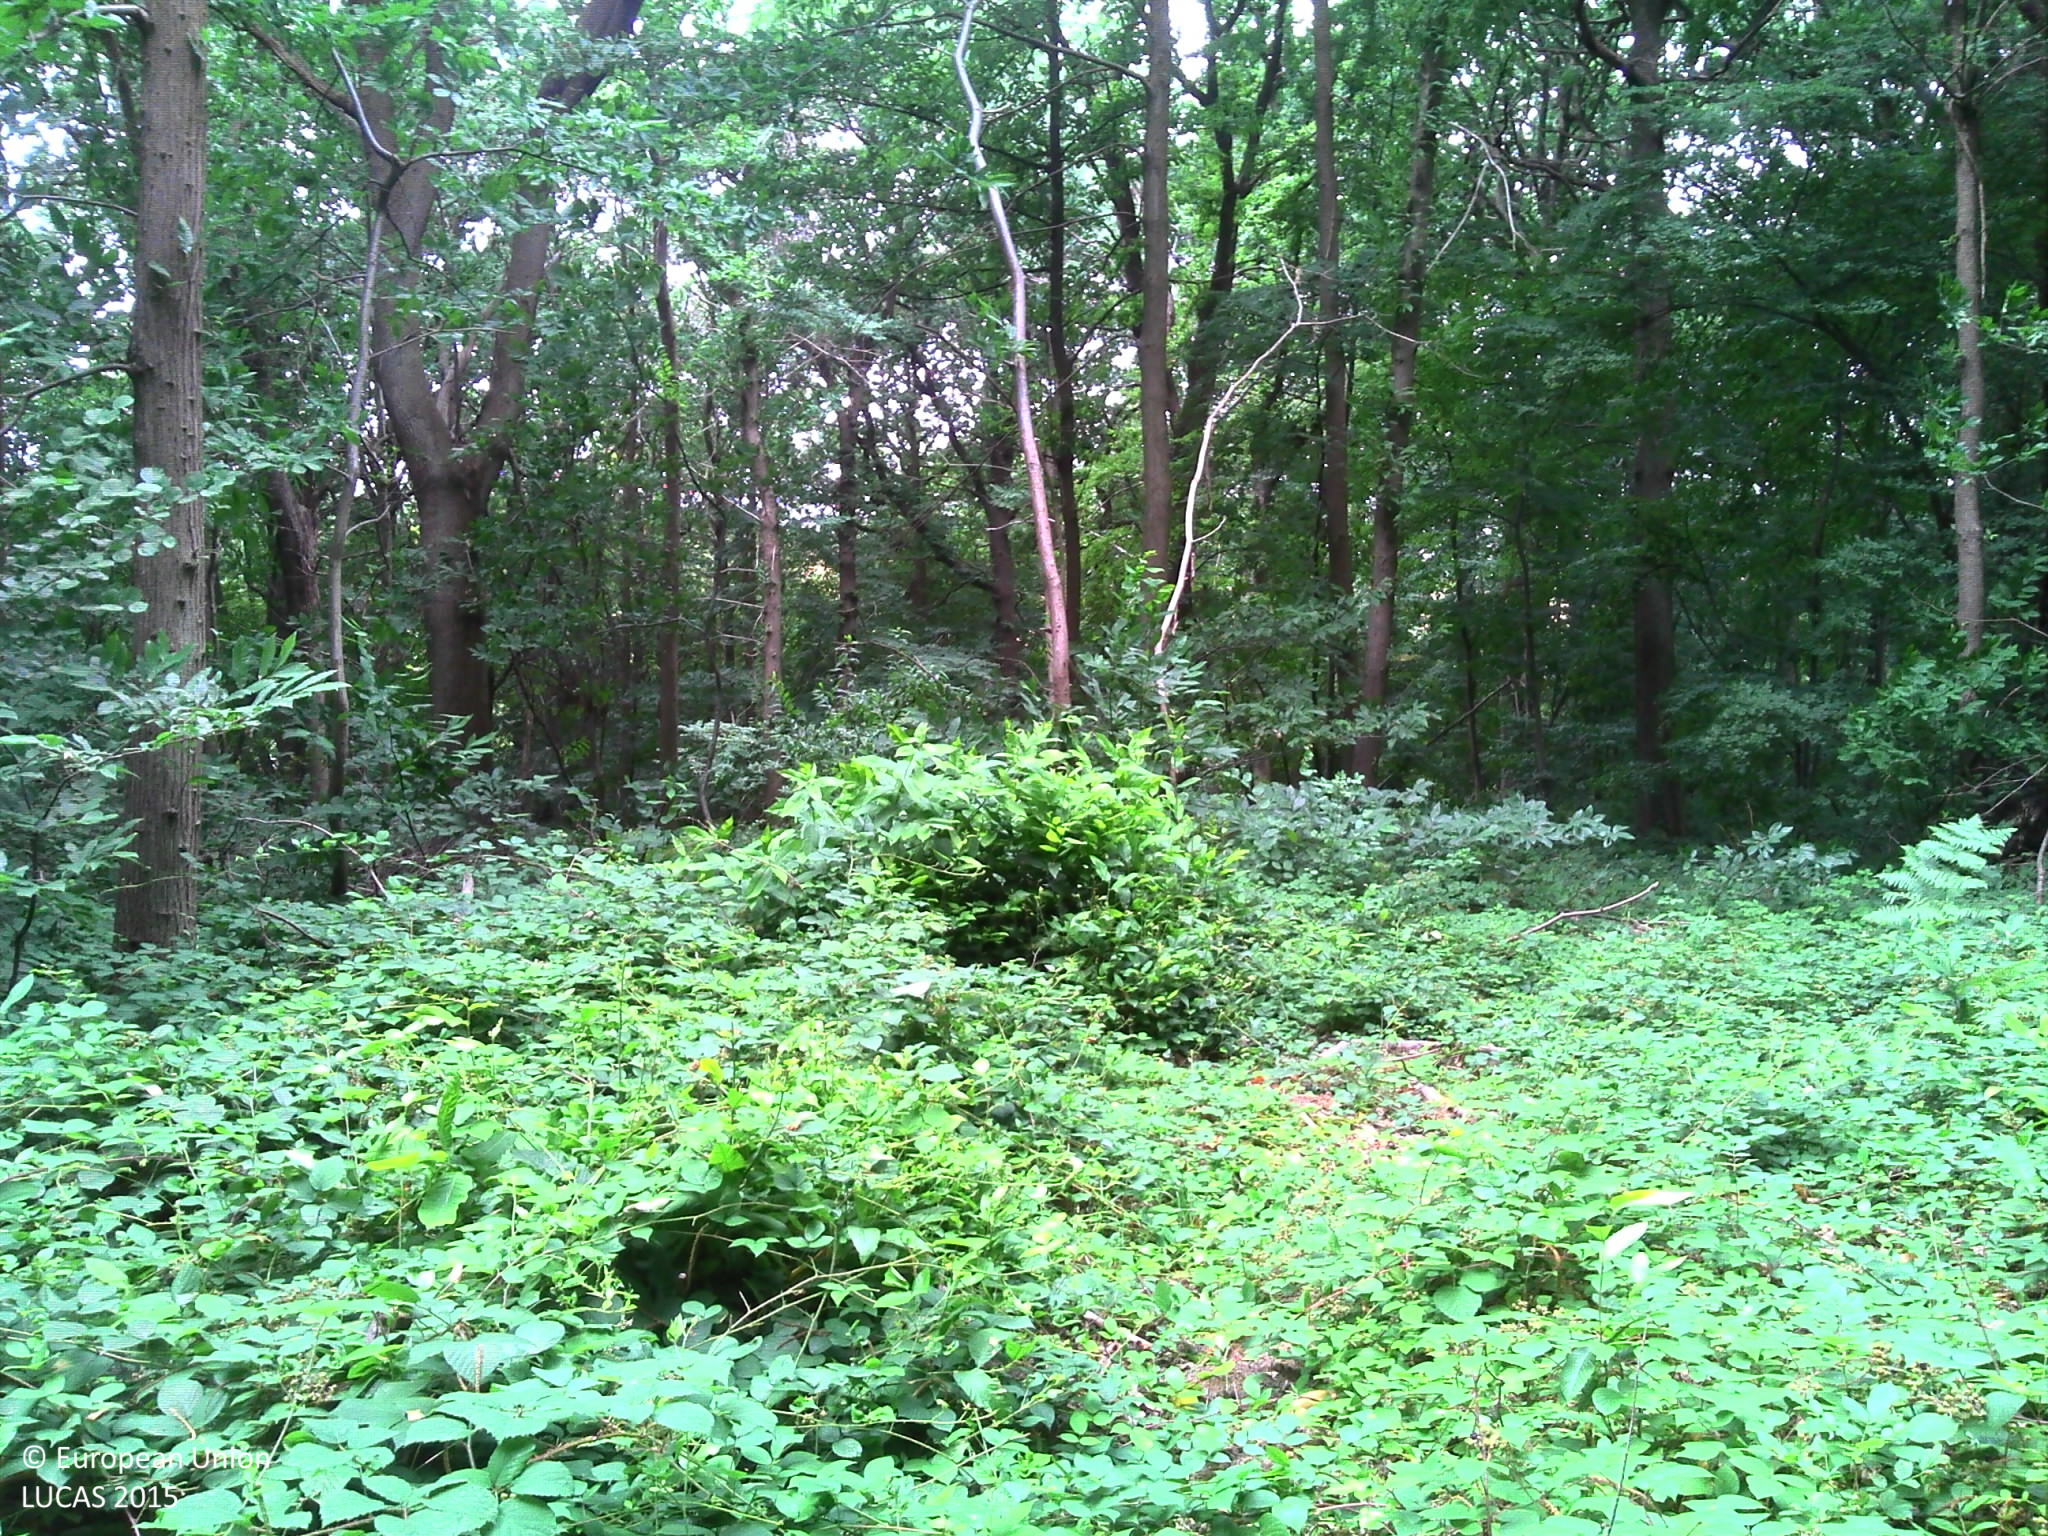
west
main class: Woodland
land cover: Broadleaved woodland
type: mesophytic deciduous forest
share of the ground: > 75 %
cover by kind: broadleaved forest trees 40 %, shrubs 20 %, lichens and mosses 10 %, consolidated bare surface 5 %
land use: Forestry
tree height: > 5 m
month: July
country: FR
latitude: 49.0929
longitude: 2.3048
